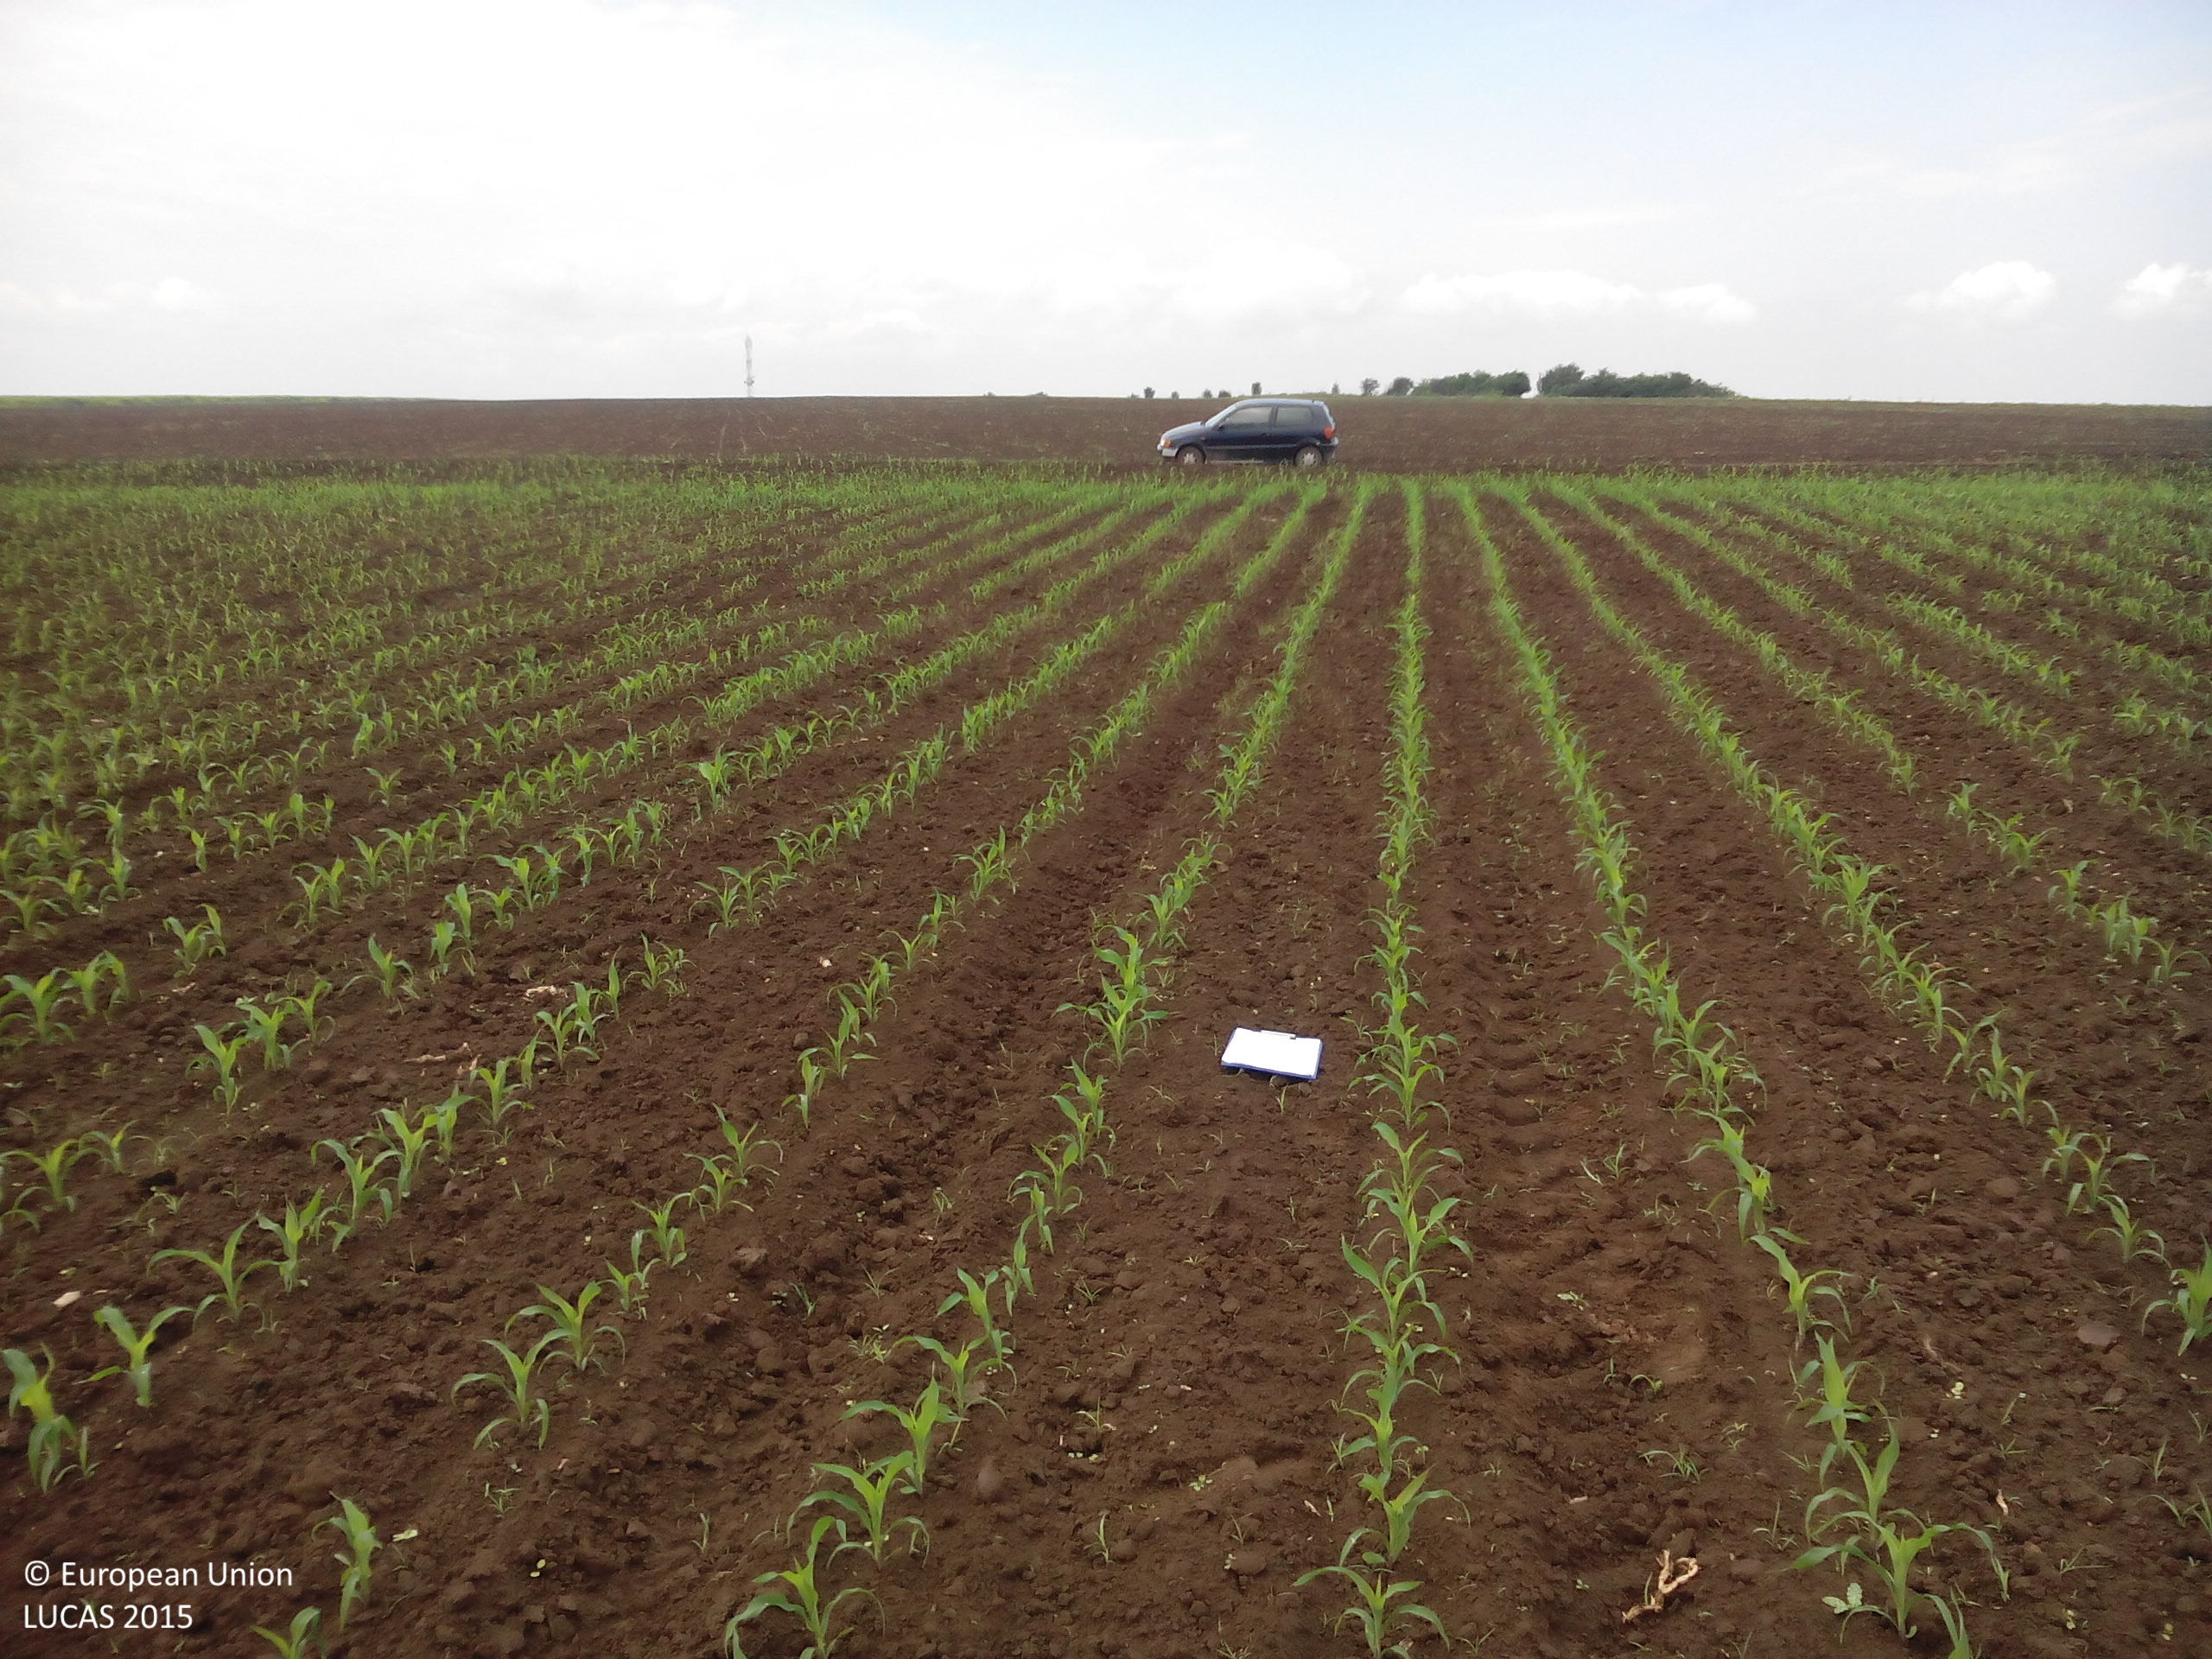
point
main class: Cropland
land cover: Maize
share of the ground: 10 - 25 %
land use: Agriculture (excluding fallow land and kitchen gardens)
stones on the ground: < 10 %
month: May
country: BG
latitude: 43.6141
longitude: 23.7414
